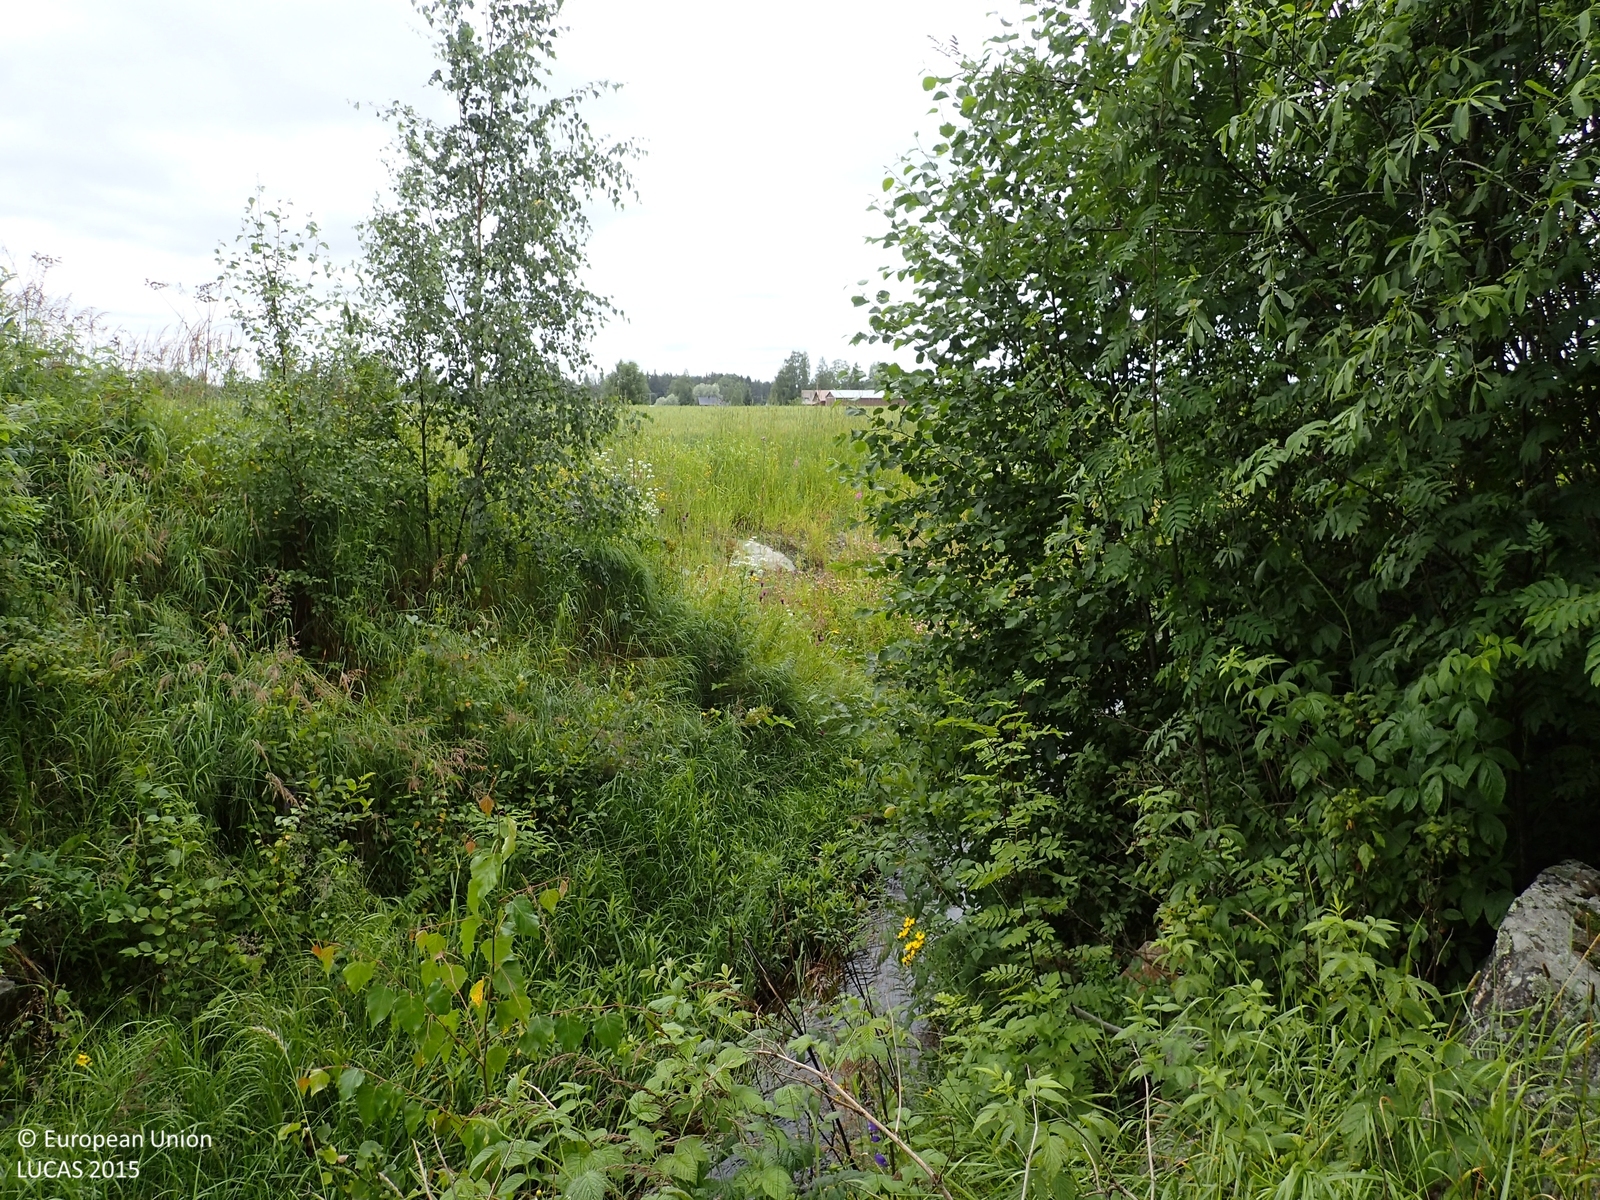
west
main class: Cropland
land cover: Common wheat
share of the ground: > 75 %
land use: Agriculture (excluding fallow land and kitchen gardens)
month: August
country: FI
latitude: 62.9108
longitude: 22.0735
